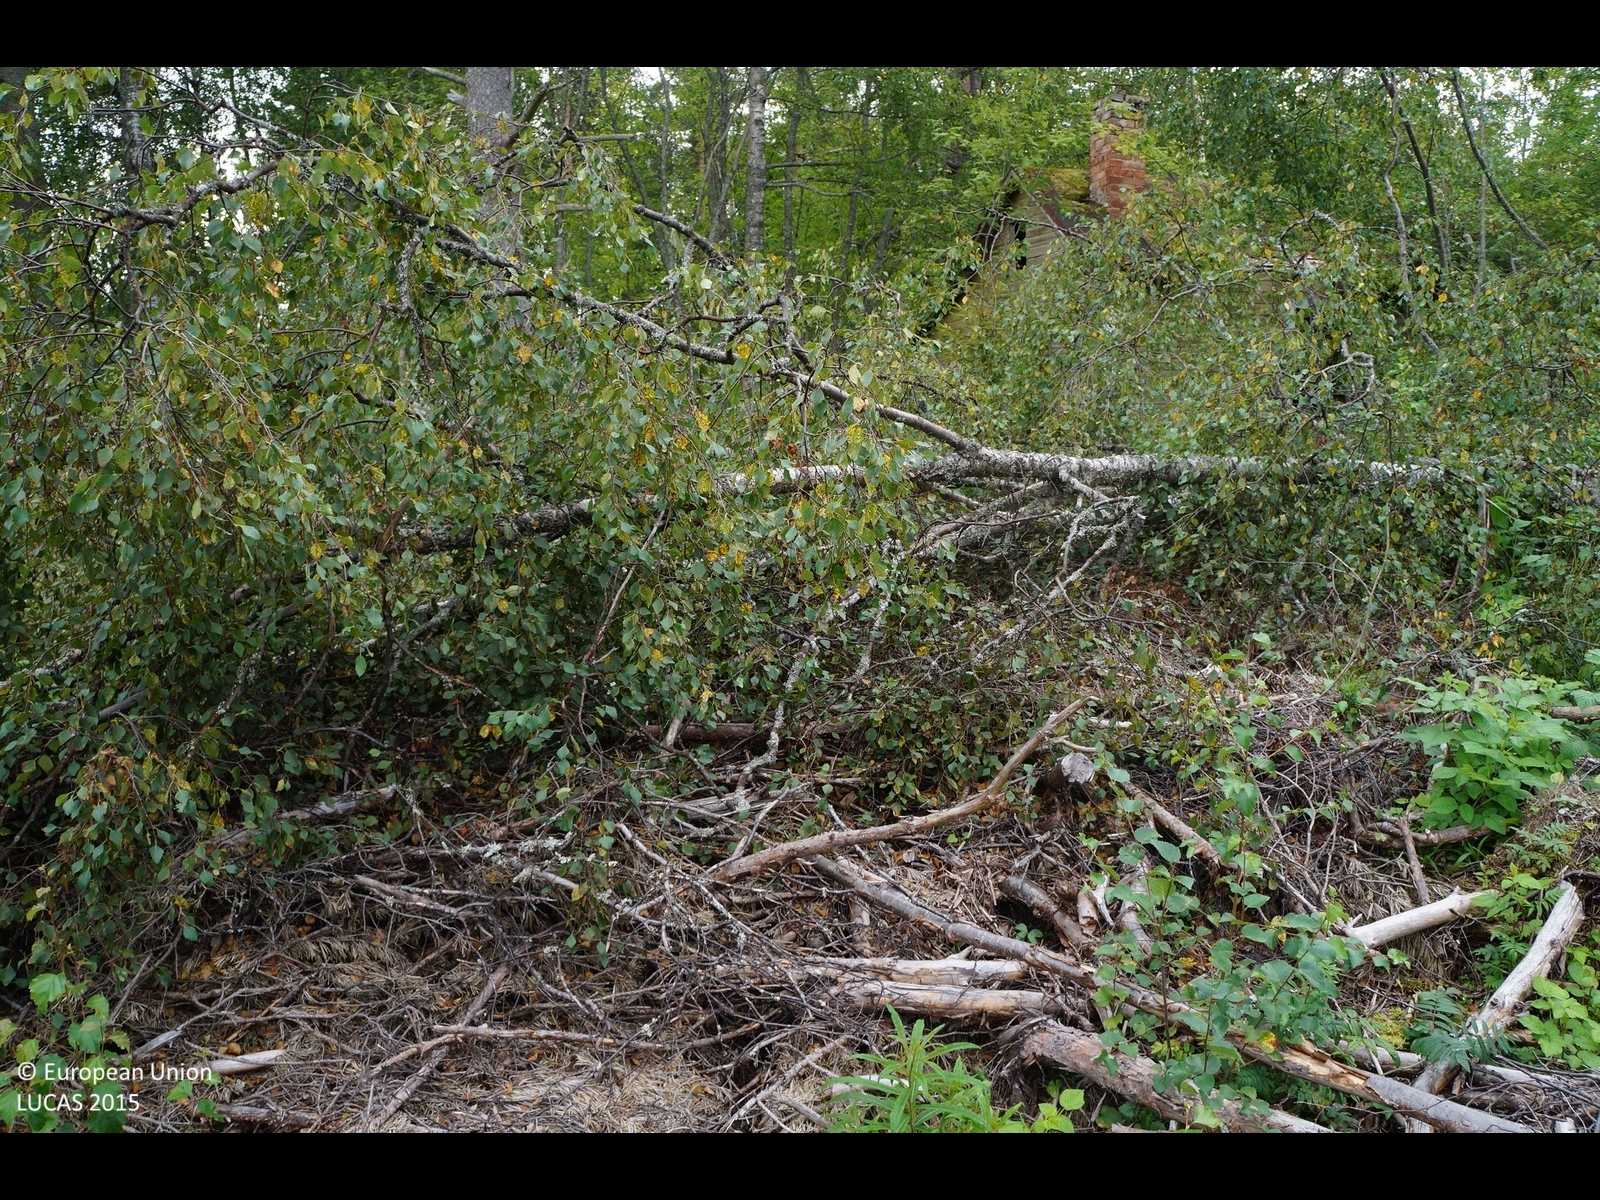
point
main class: Shrubland
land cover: Shrubland without tree cover
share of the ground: 25 - 50 %
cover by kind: shrubs 35 %, herbaceous plants 20 %, unconsolidated bare surface 10 %
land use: Forestry
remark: Clear cut
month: August
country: FI
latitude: 64.7879
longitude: 25.3799
